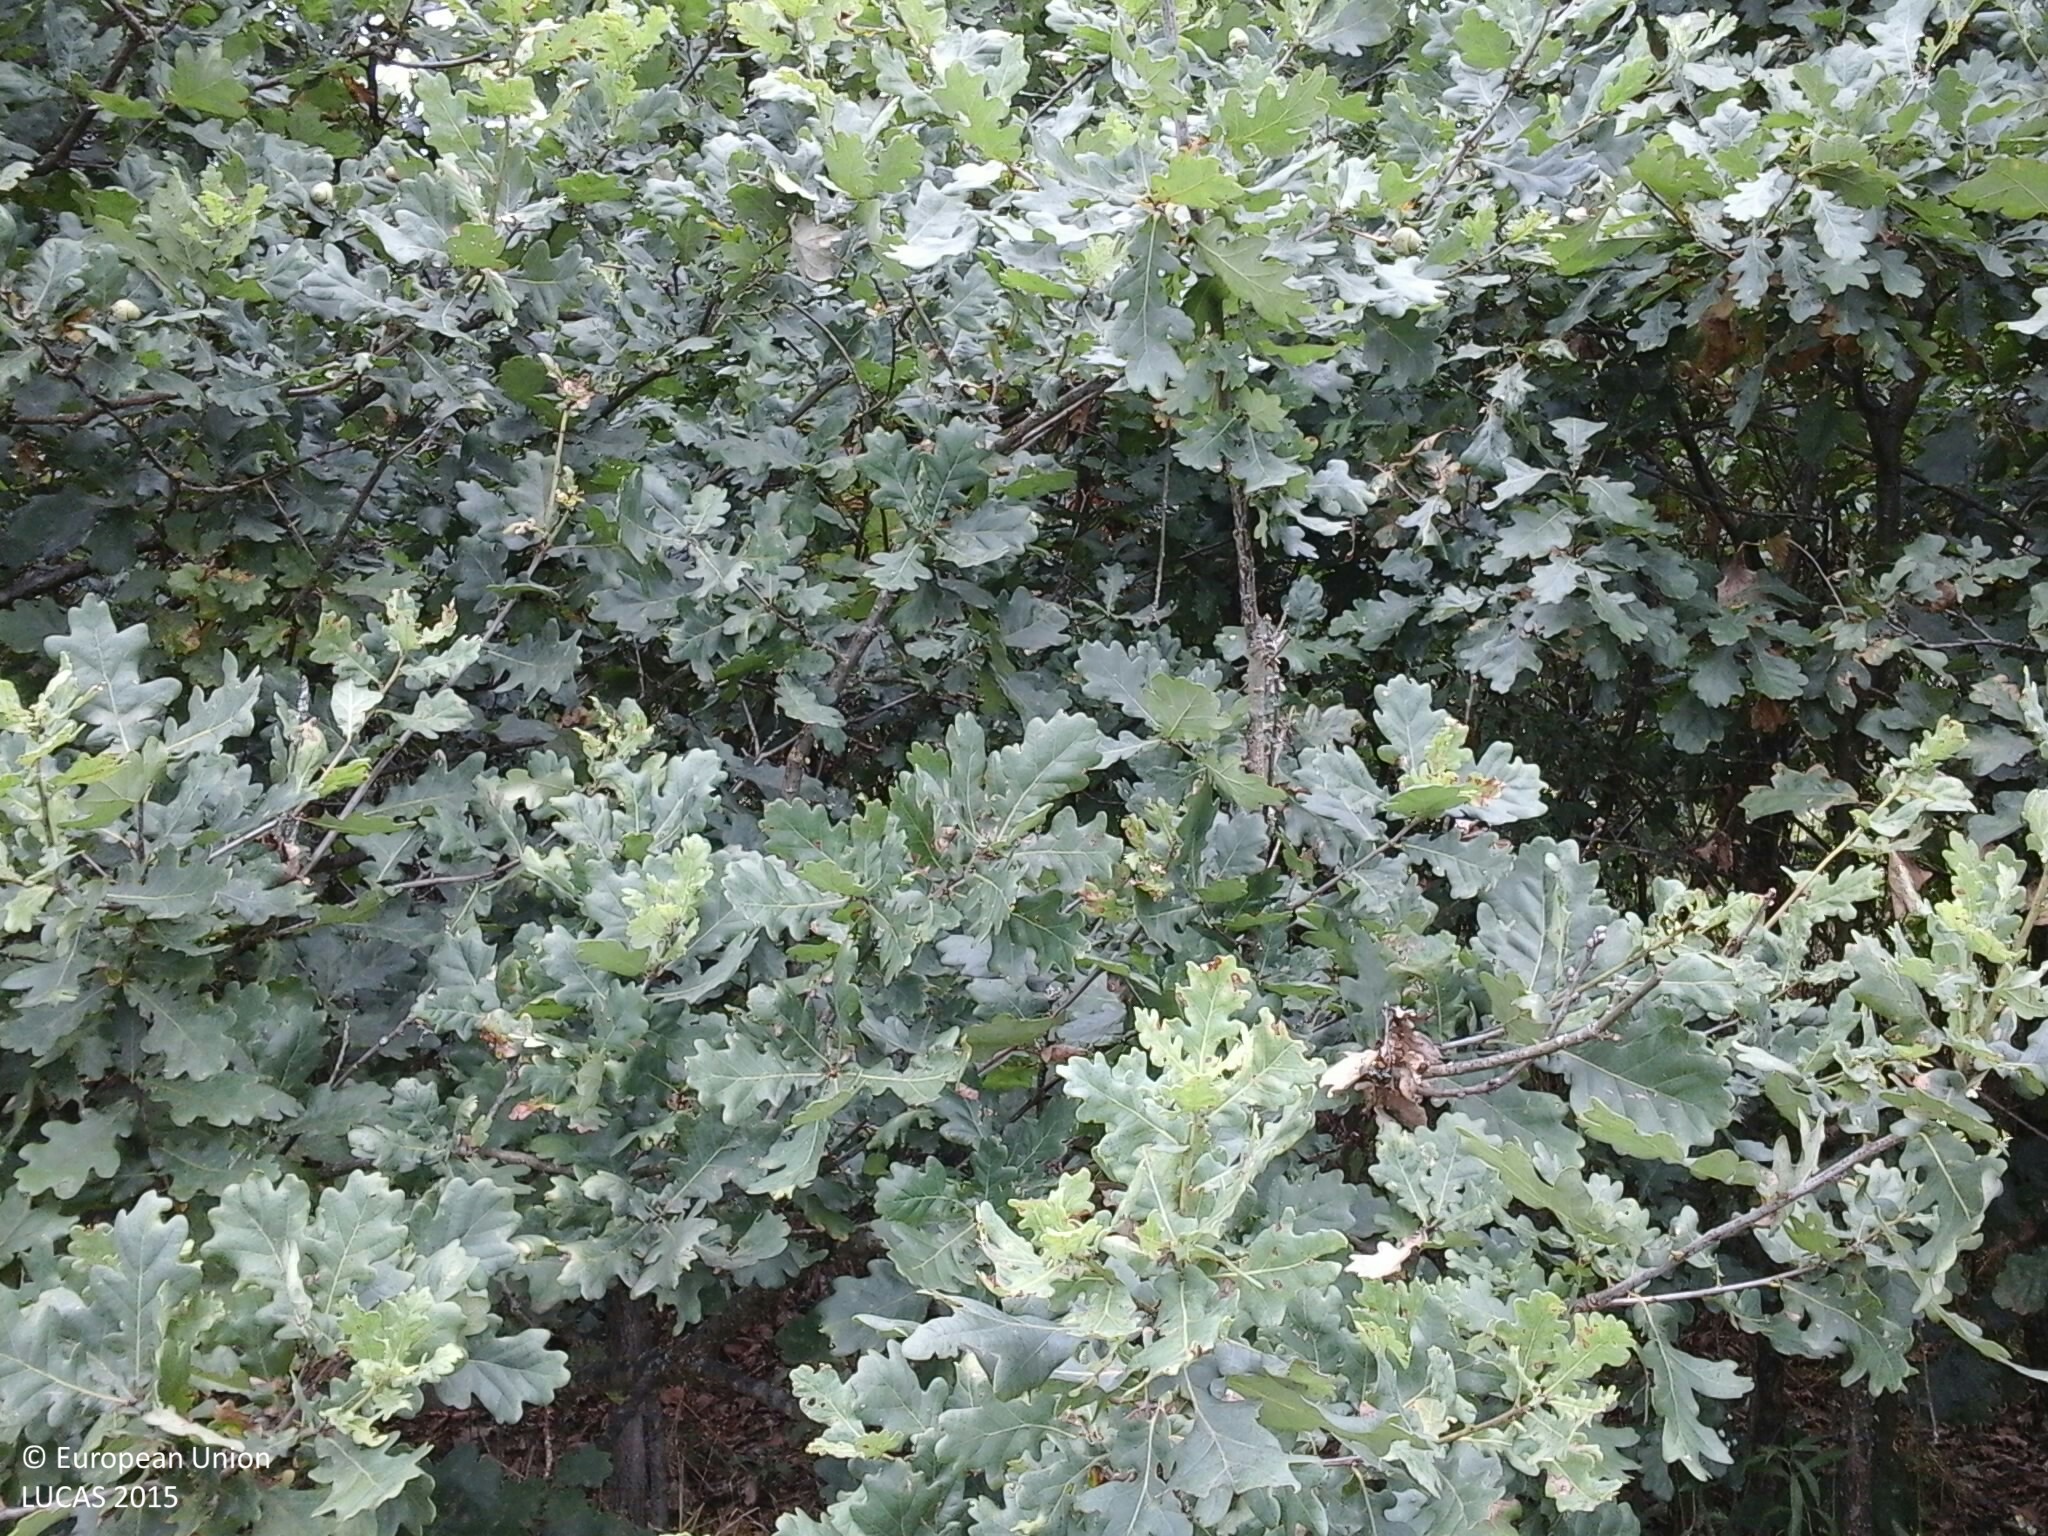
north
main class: Shrubland
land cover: Shrubland with sparse tree cover
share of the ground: > 75 %
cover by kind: shrubs 65 %, herbaceous plants 30 %, broadleaved forest trees 5 %
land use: Semi-natural and natural areas not in use
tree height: < 5 m
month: July
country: HU
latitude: 46.7117
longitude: 16.5293
